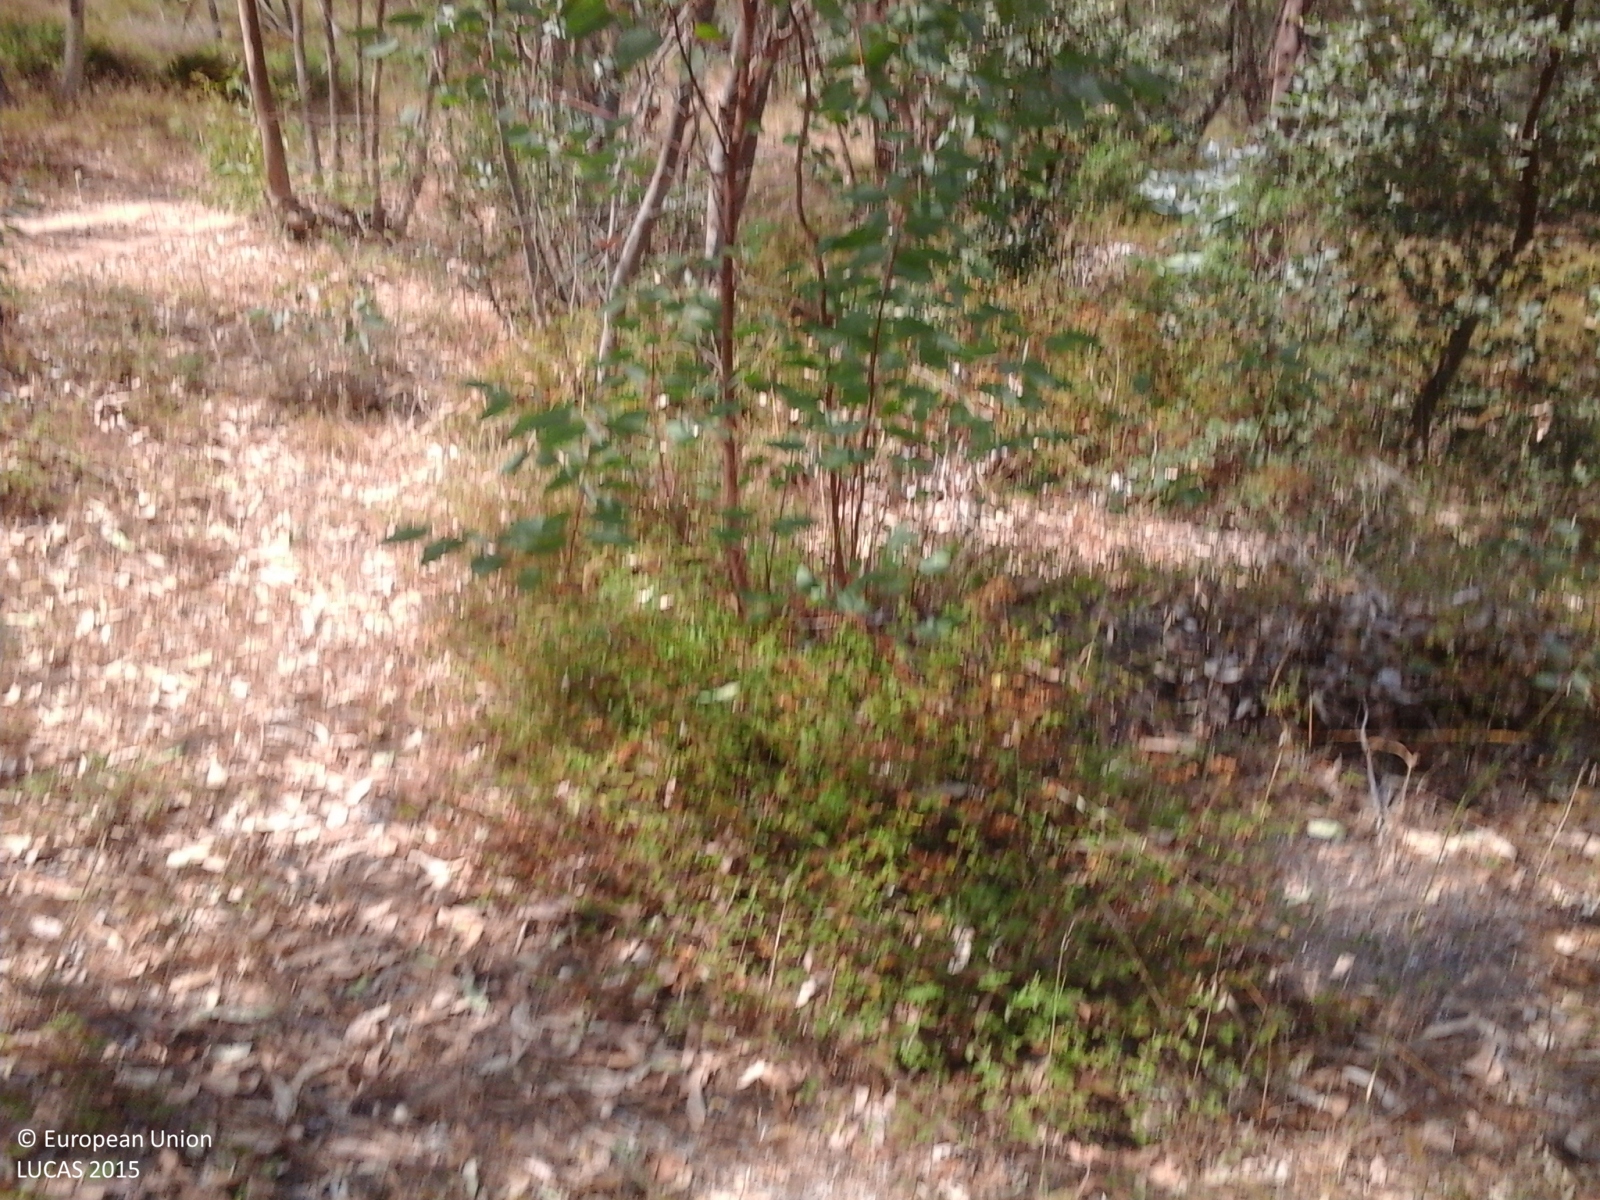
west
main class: Woodland
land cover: Broadleaved woodland
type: broadleaved evergreen forest
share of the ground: > 75 %
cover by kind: broadleaved forest trees 100 %
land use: Forestry
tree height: > 5 m
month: July
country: IT
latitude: 37.2660
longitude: 14.3532
